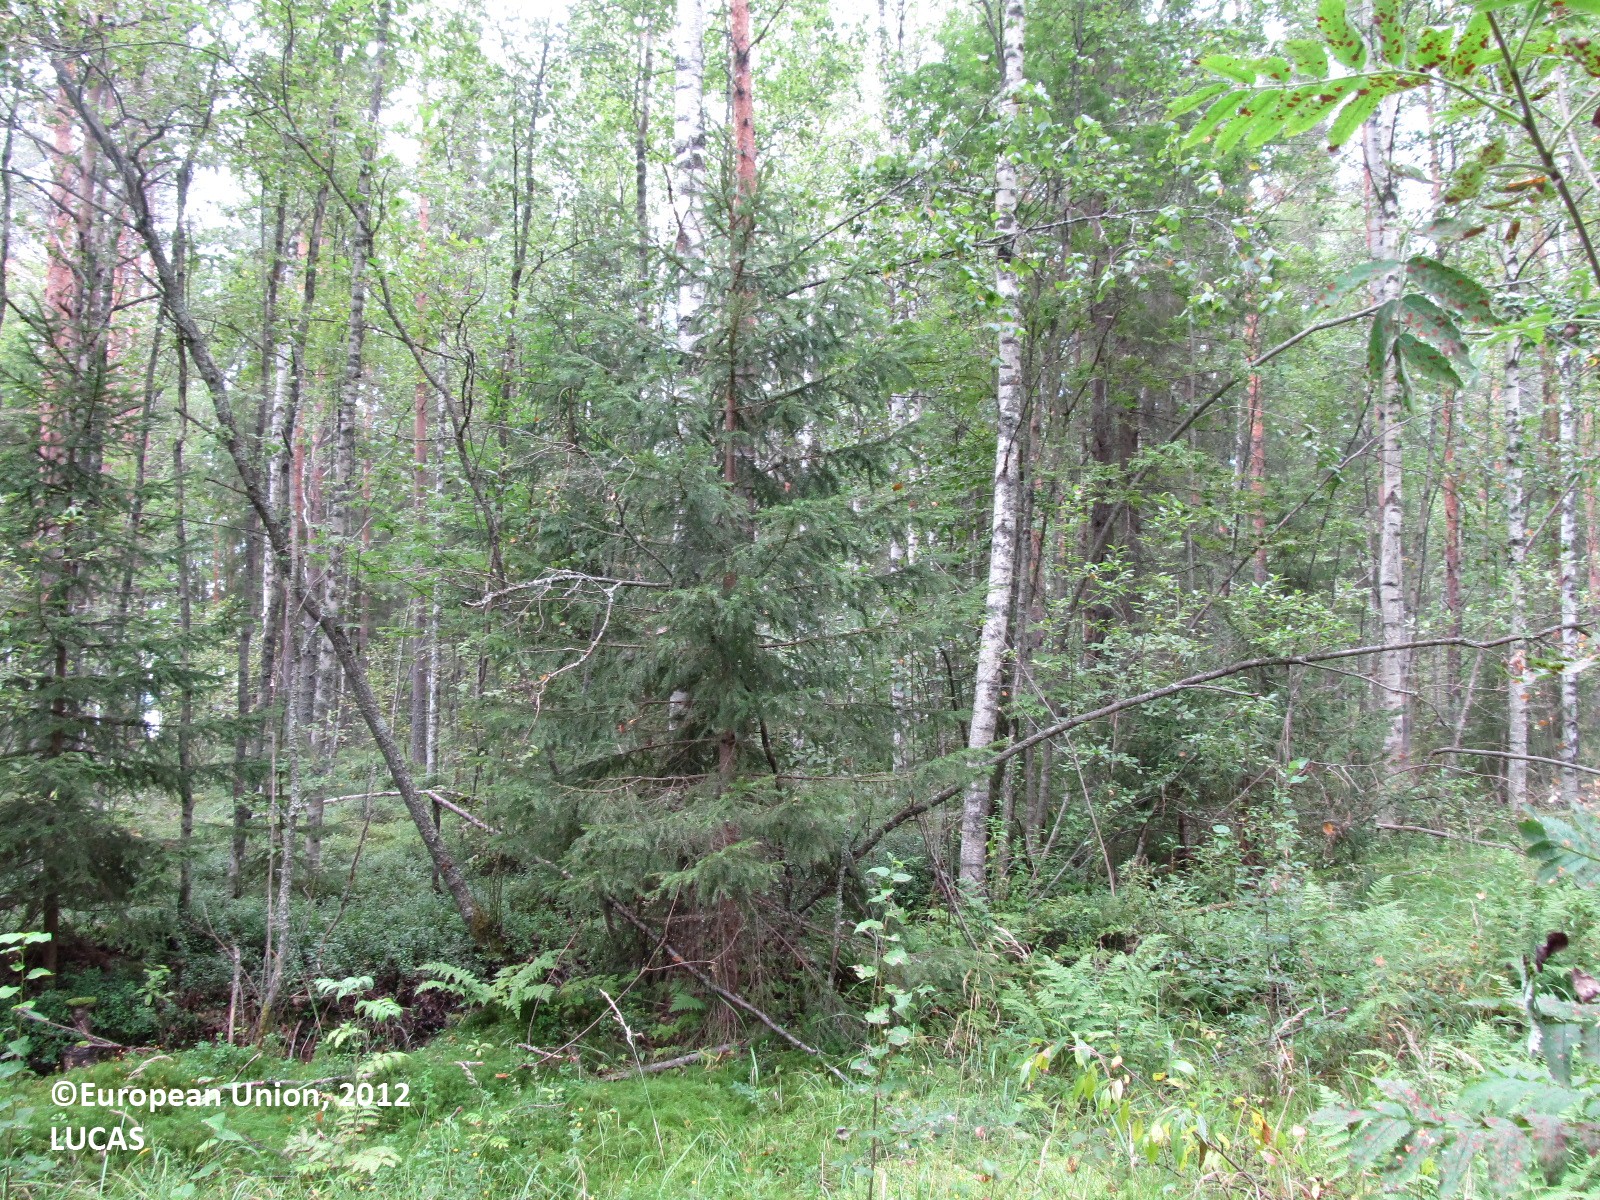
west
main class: Woodland
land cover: Spruce dominated mixed woodland
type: boreal forest
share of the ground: 25 - 50 %
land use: Forestry
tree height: > 5 m
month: August
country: FI
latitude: 62.0109
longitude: 27.4177
